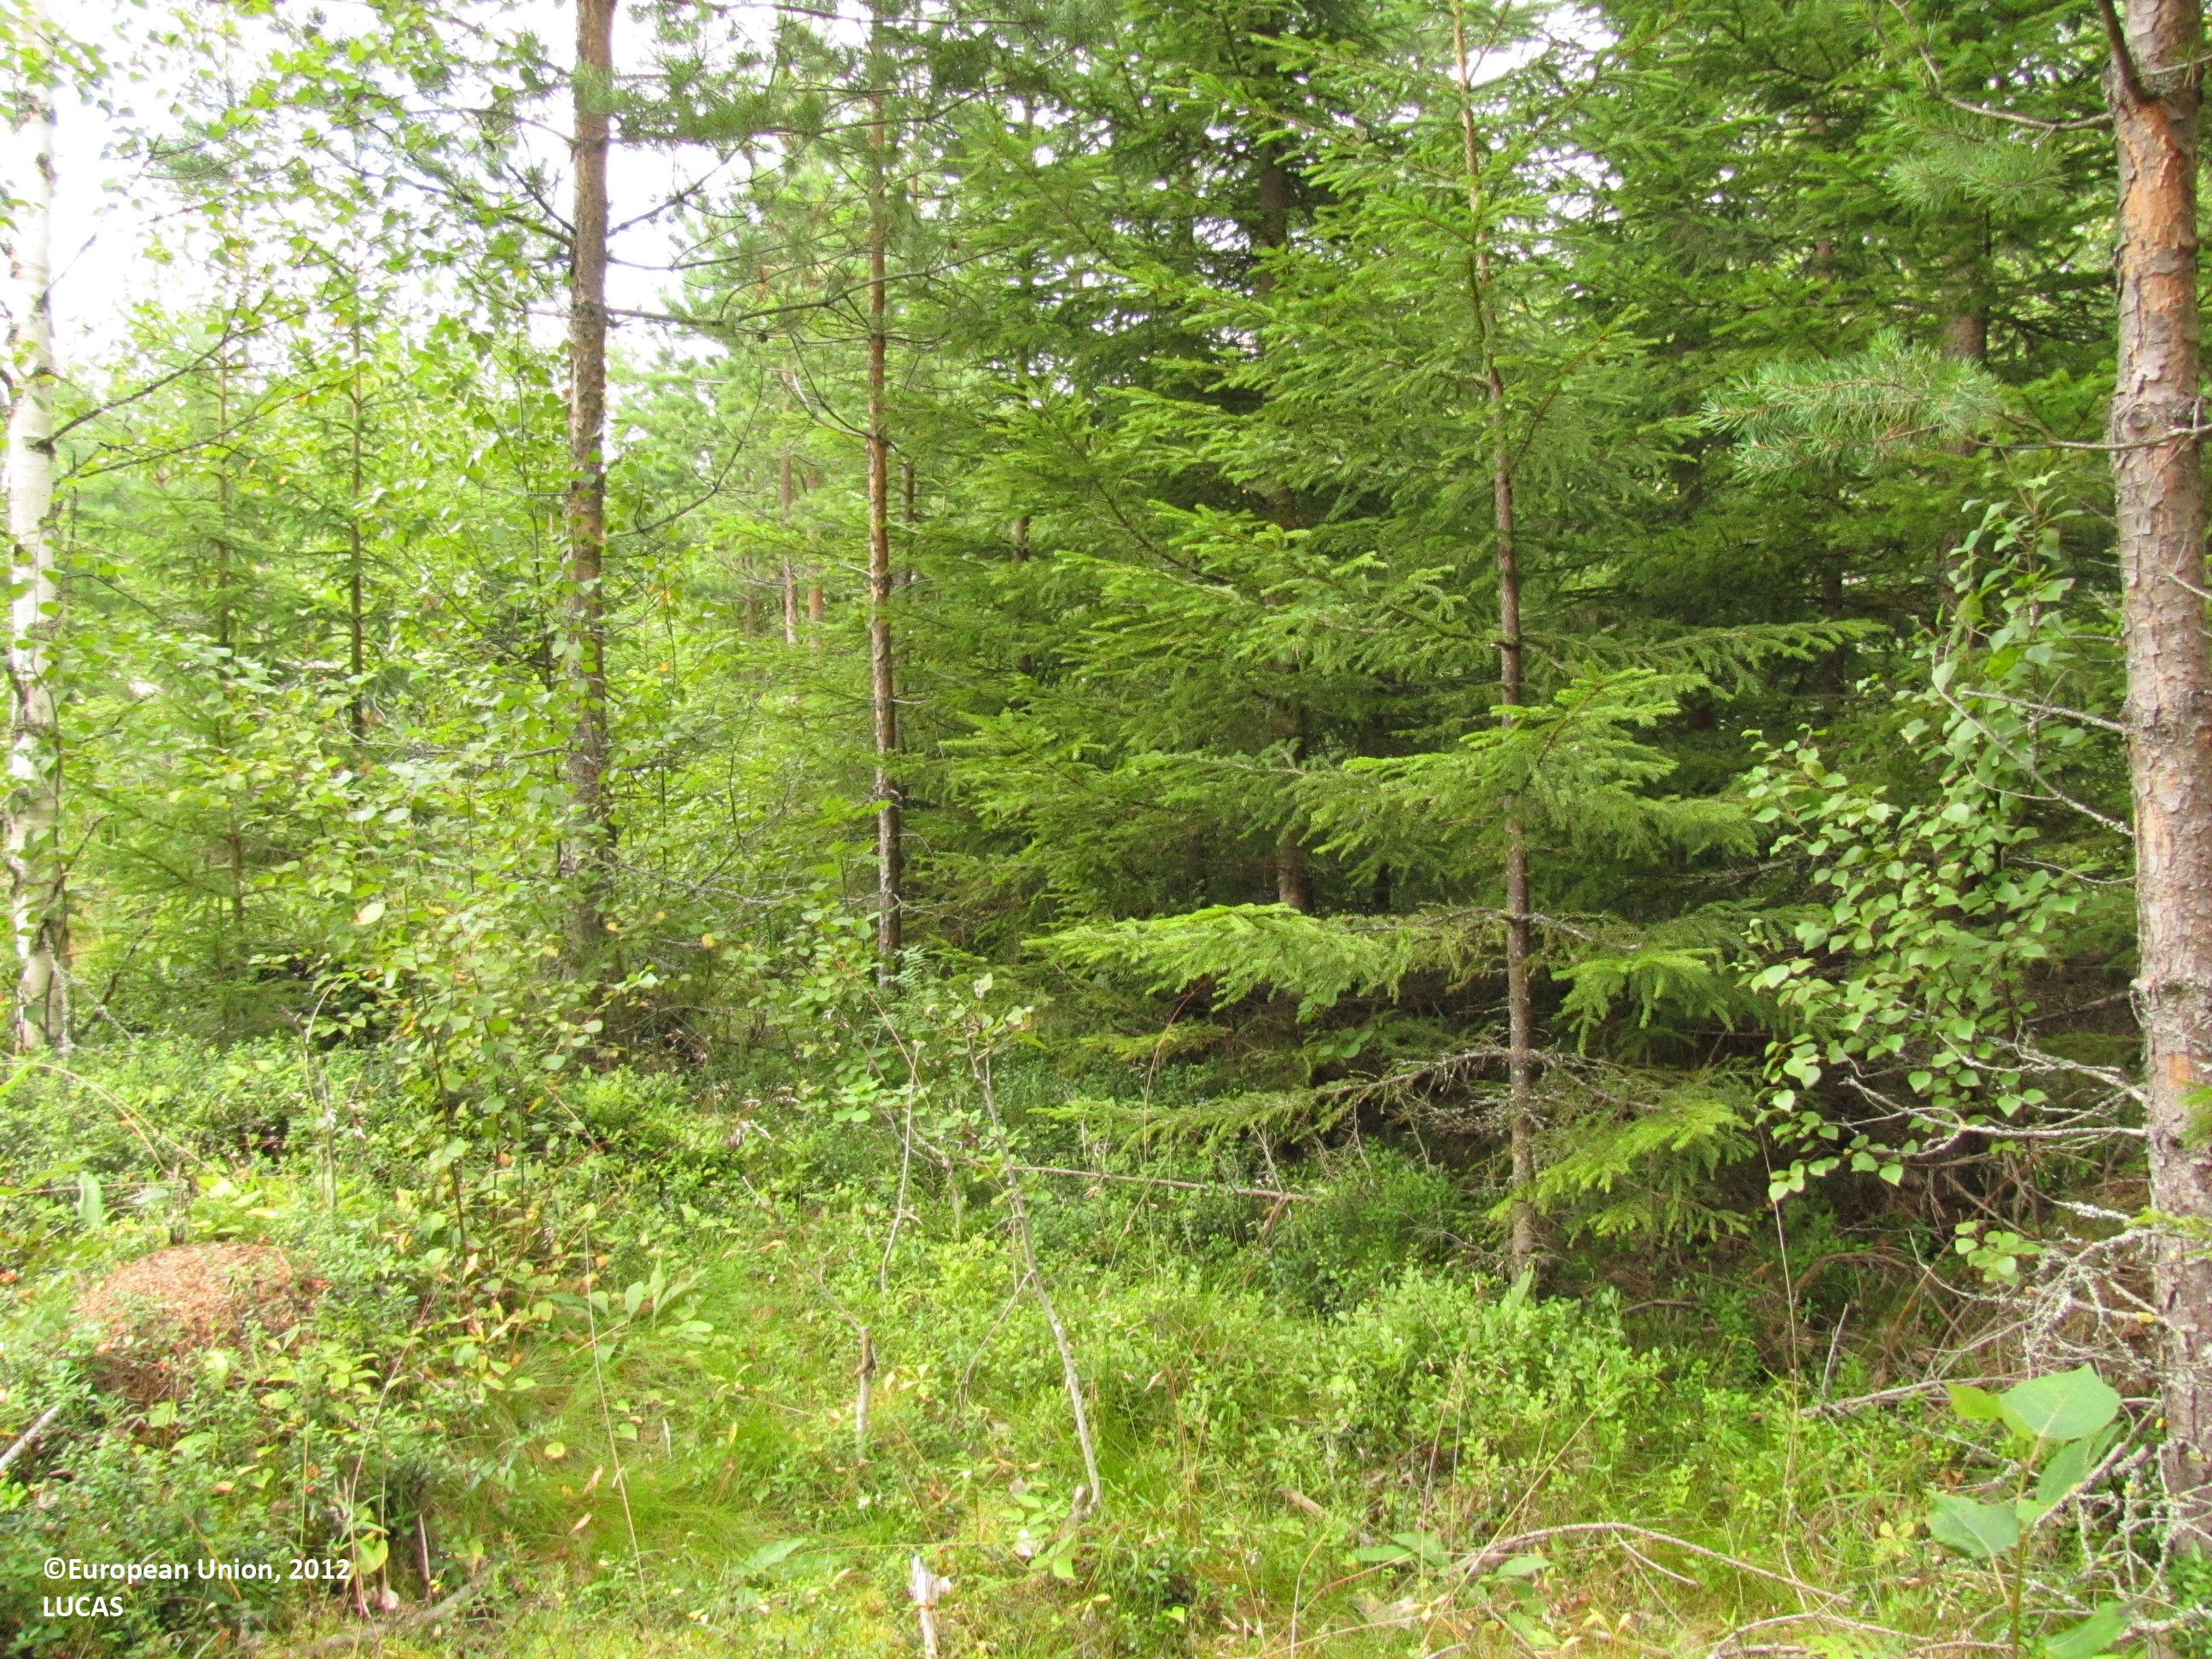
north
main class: Woodland
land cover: Pine dominated mixed woodland
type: boreal forest
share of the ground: 25 - 50 %
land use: Forestry
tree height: < 5 m
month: August
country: FI
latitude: 61.8692
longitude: 23.1318
